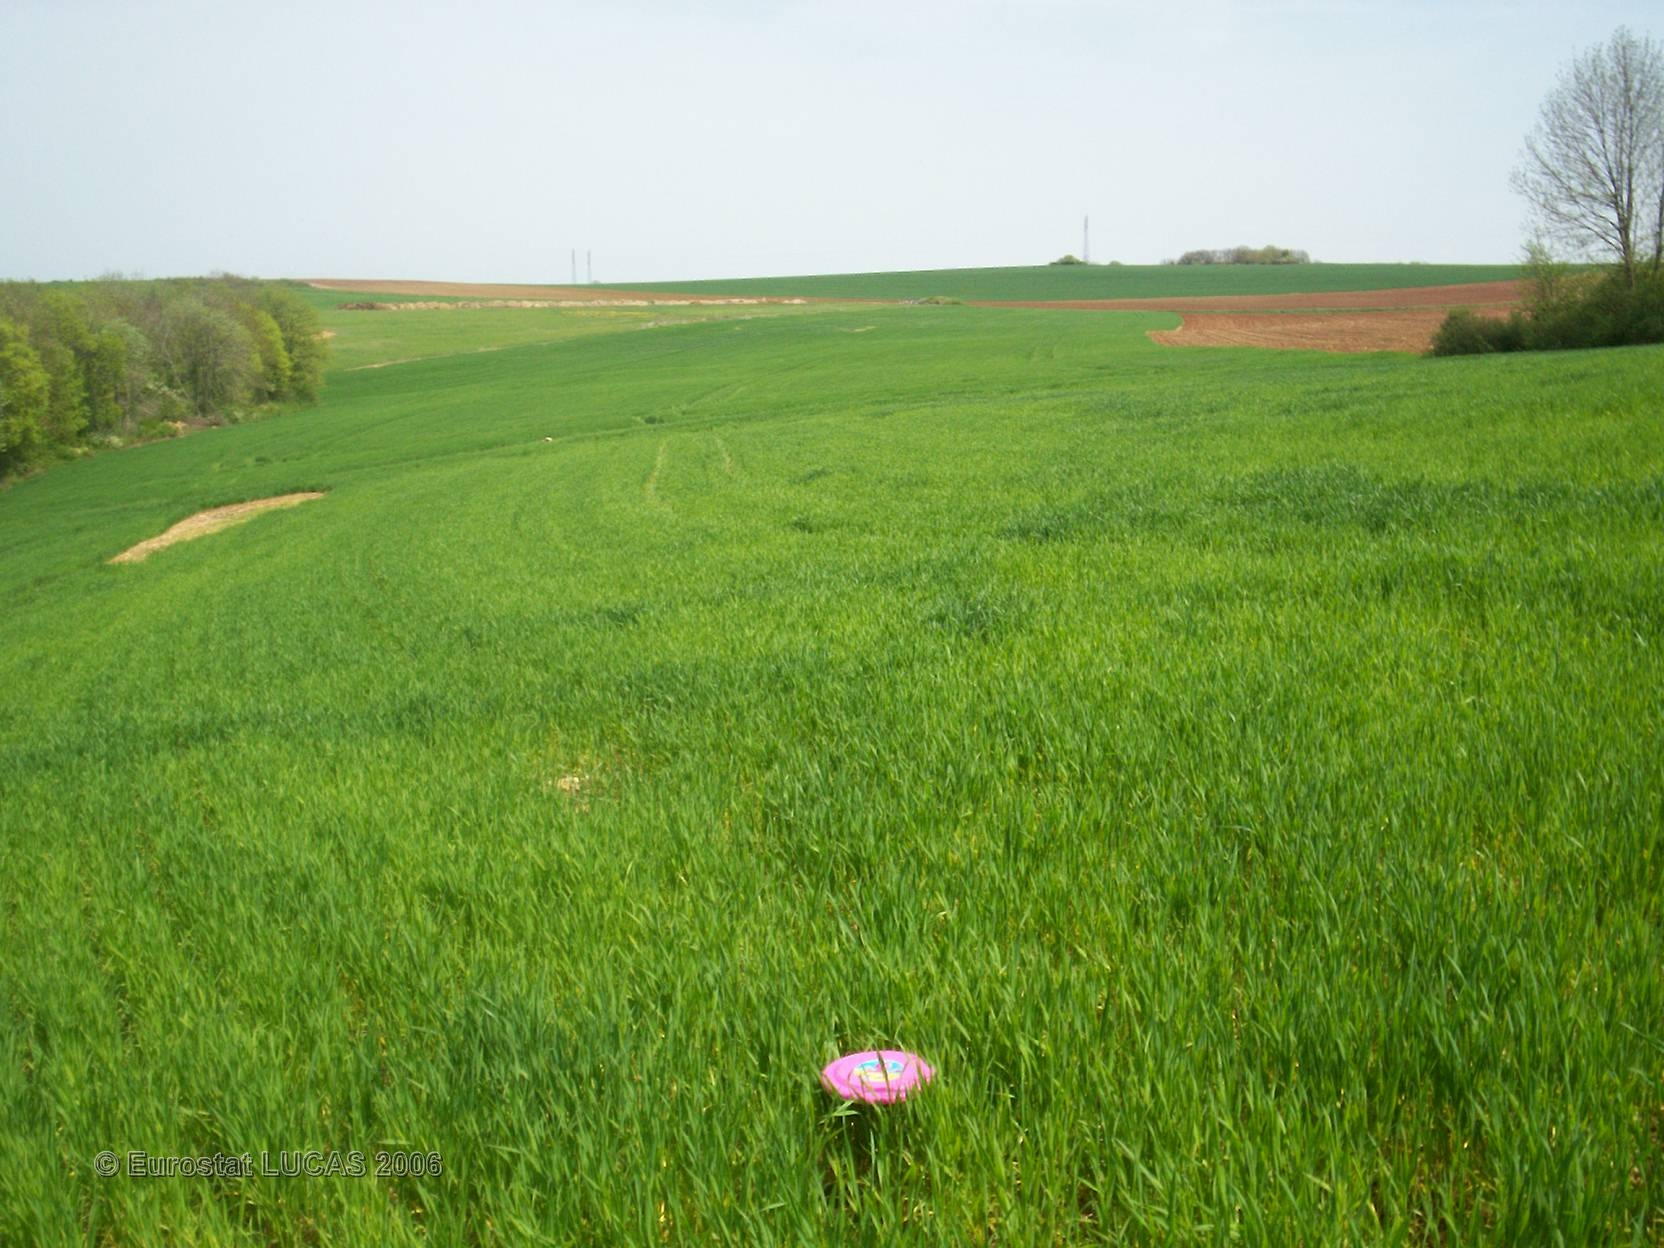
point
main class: Cropland
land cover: Common wheat
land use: Agriculture (excluding fallow land and kitchen gardens)
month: May
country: FR
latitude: 47.4805
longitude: 4.6515
